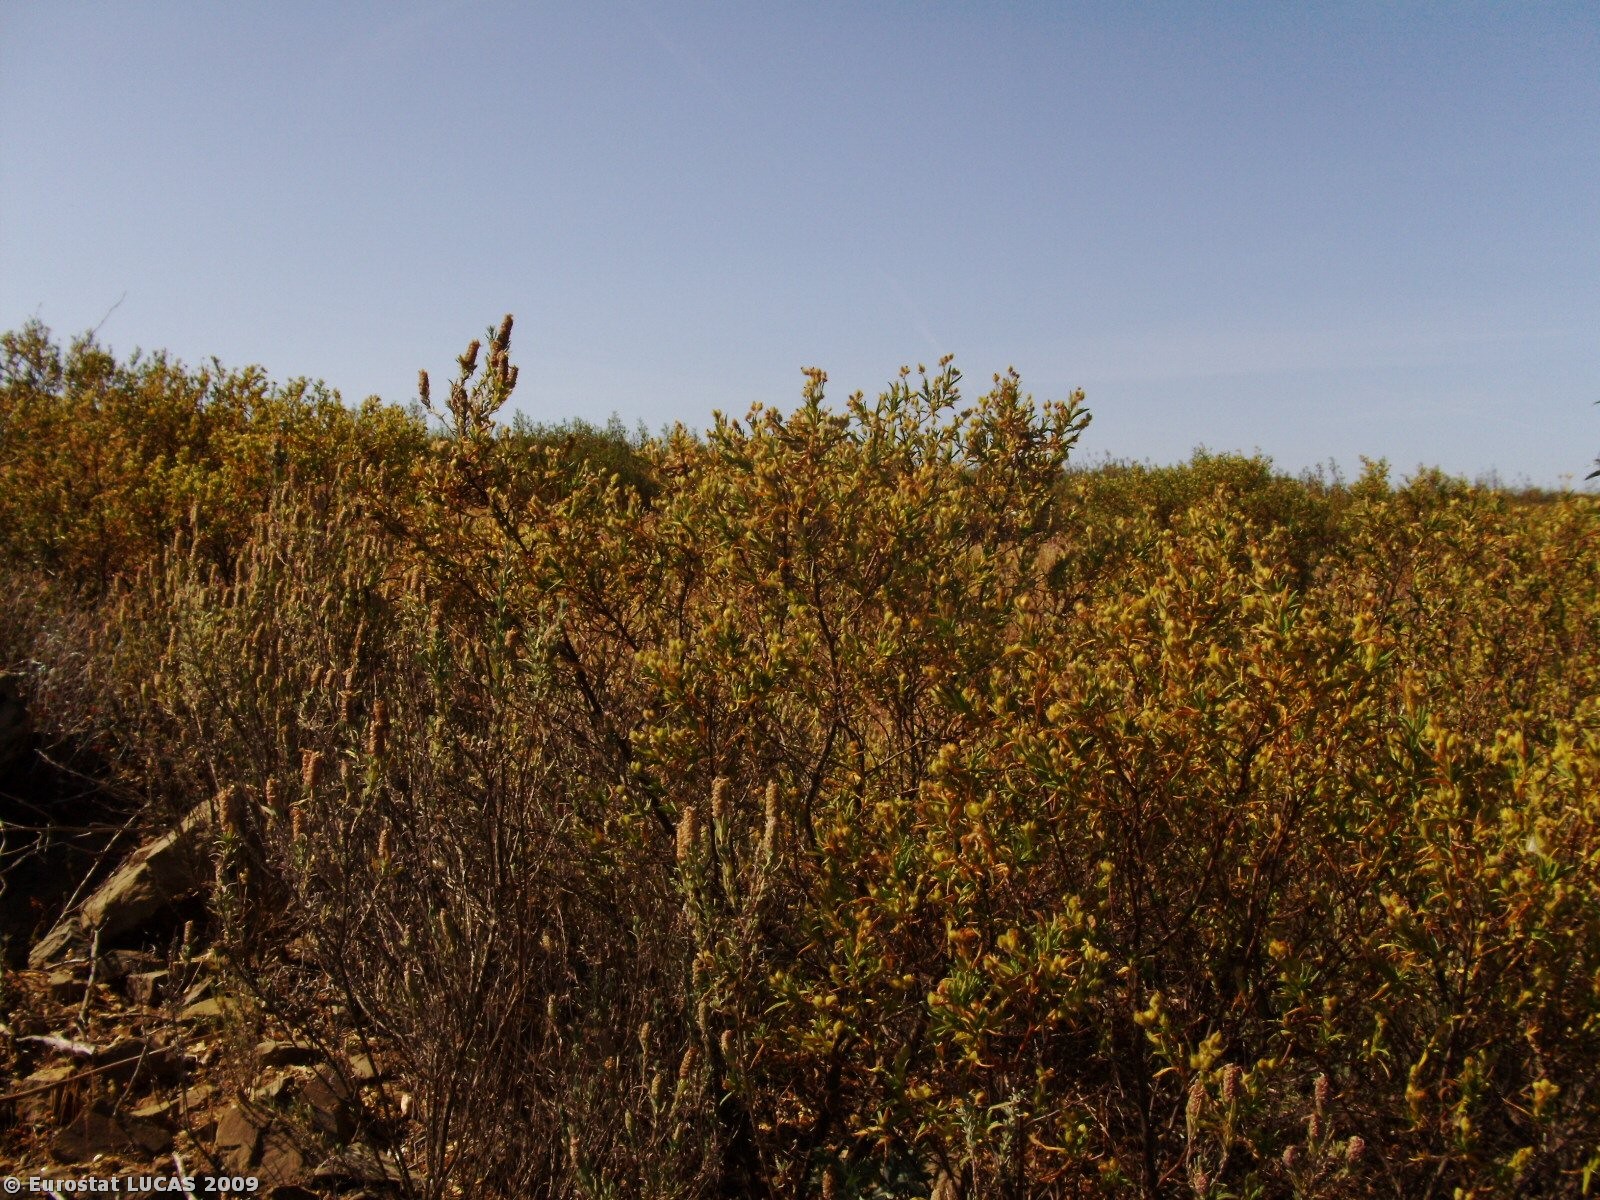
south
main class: Shrubland
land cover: Shrubland without tree cover
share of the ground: 50 - 75 %
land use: Nature reserves
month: May
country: PT
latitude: 37.5414
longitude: -7.5653
